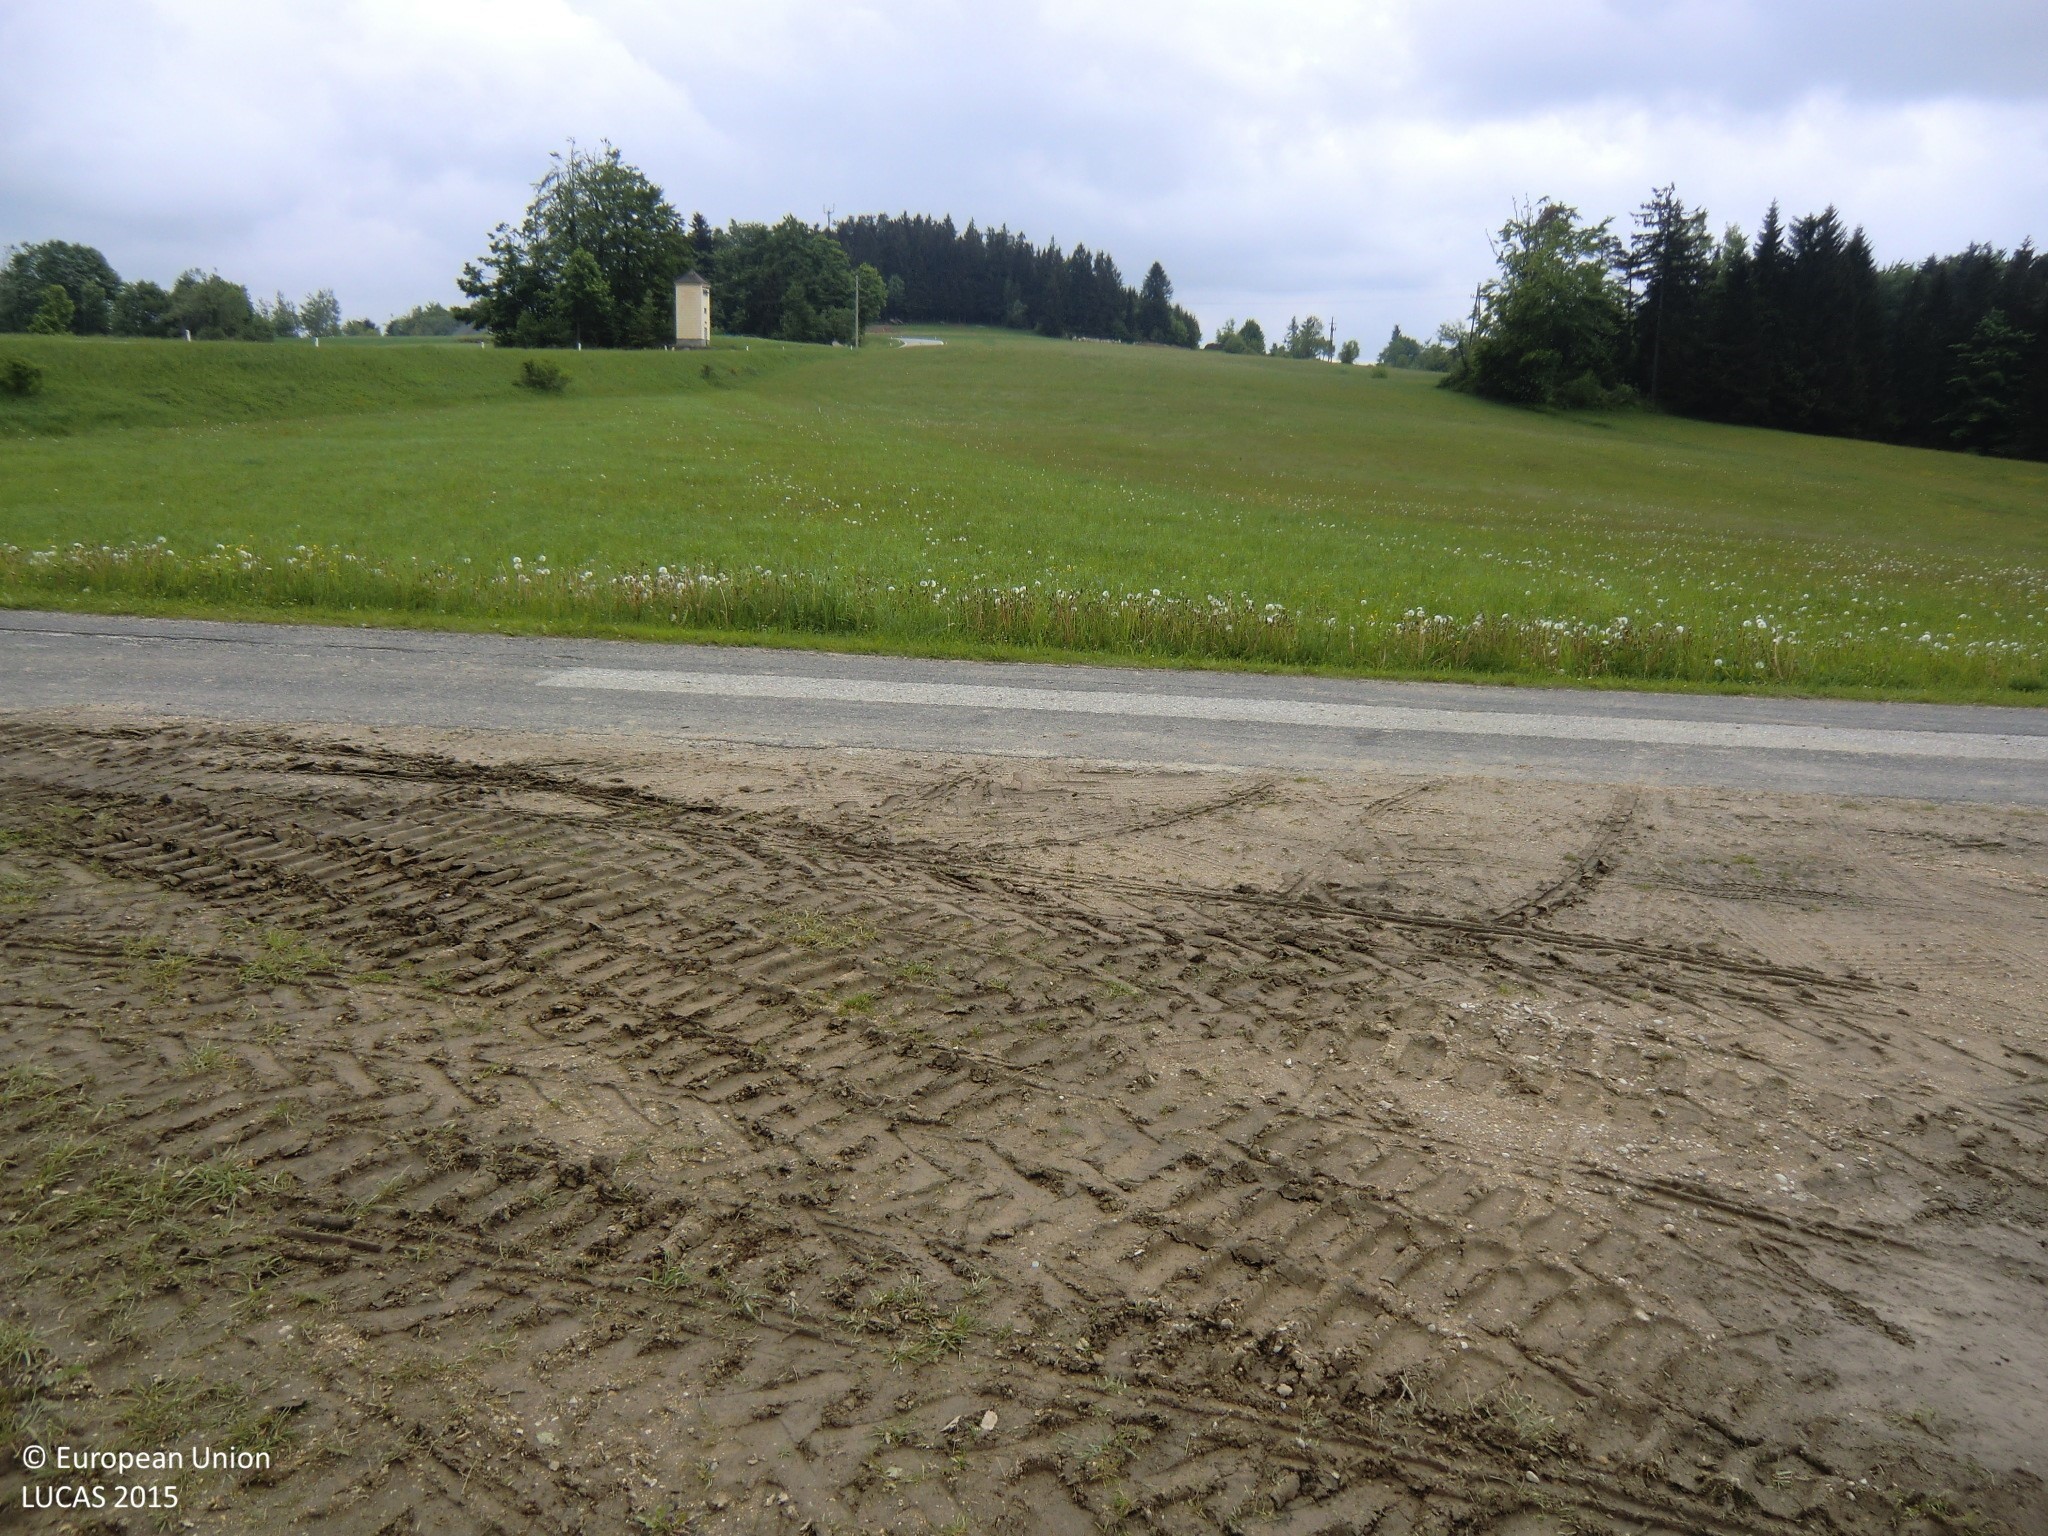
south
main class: Grassland
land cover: Spontaneously vegetated surfaces
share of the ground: 25 - 50 %
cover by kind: herbaceous plants 50 %, unconsolidated bare surface 50 %
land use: Residential
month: May
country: AT
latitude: 48.4363
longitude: 14.9621
